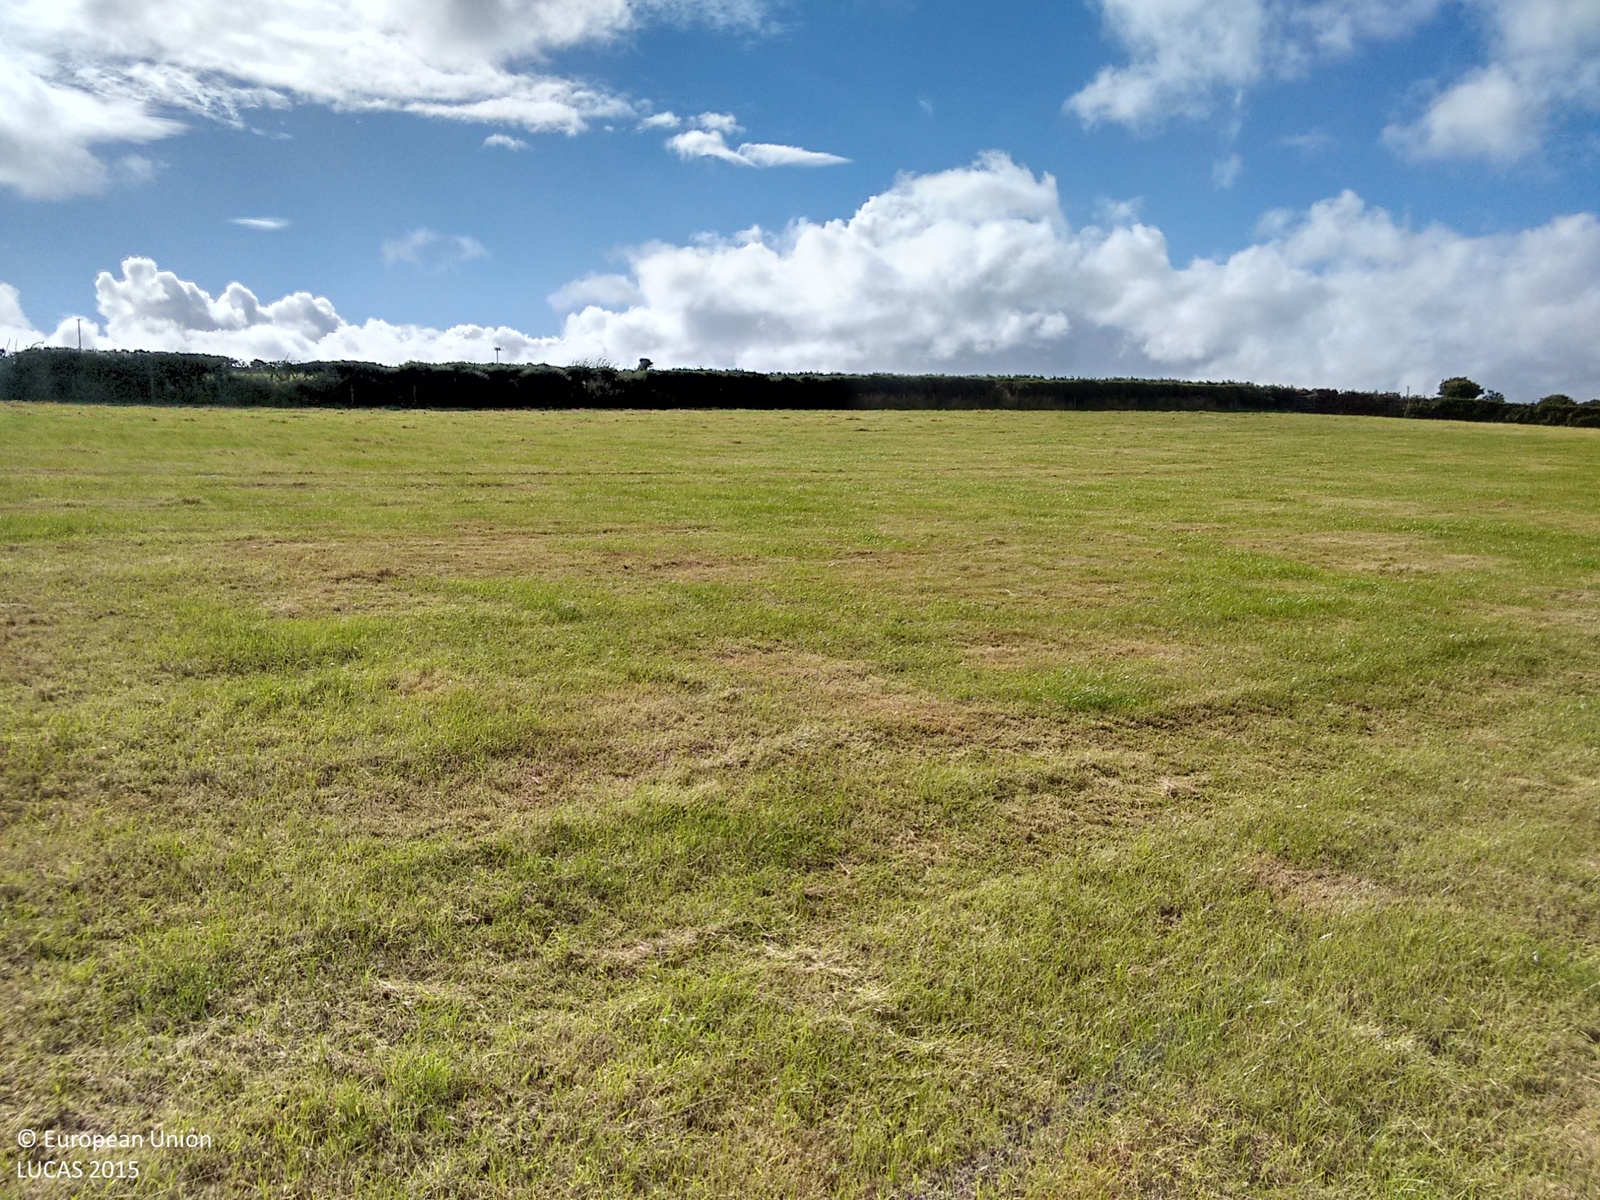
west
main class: Grassland
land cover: Grassland without tree/shrub cover
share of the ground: > 75 %
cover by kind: herbaceous plants 75 %, consolidated bare surface 25 %
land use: Agriculture (excluding fallow land and kitchen gardens)
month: August
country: GB
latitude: 52.0928
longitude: -4.7212
